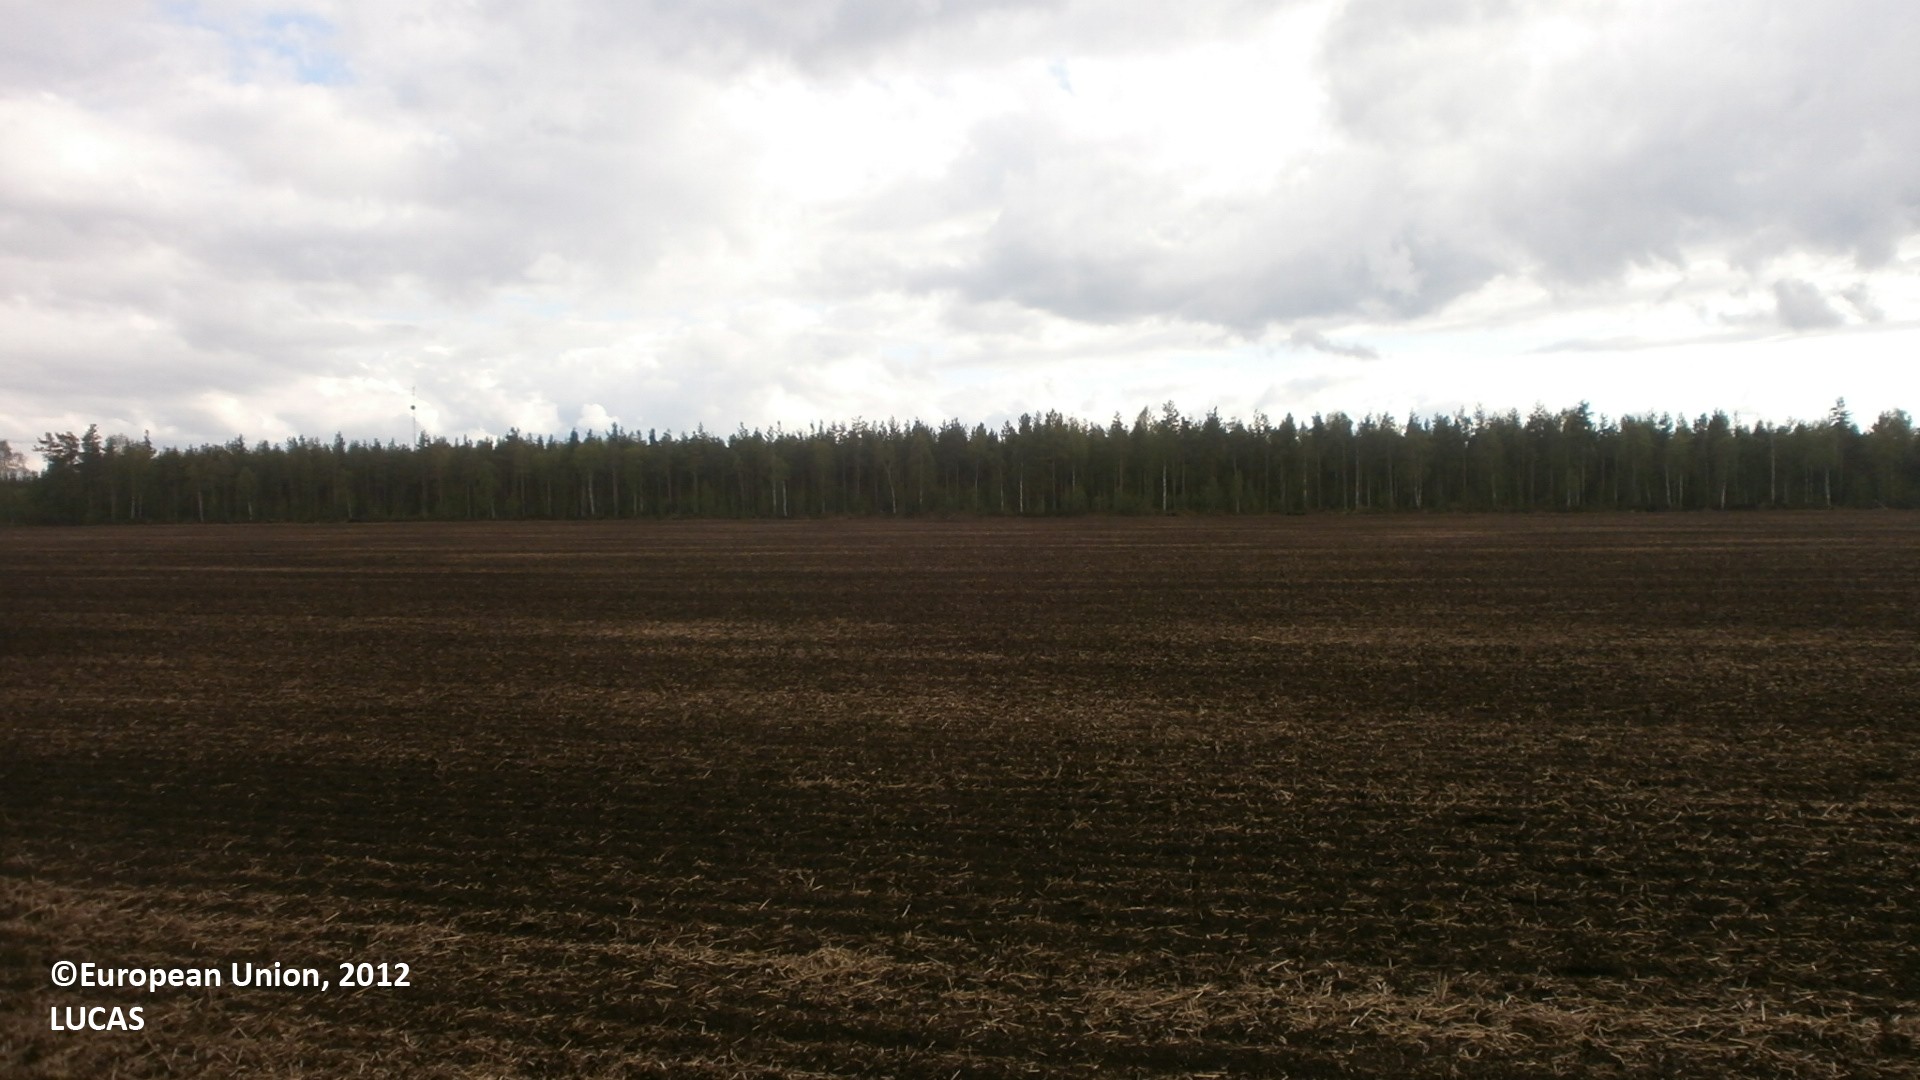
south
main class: Cropland
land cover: Barley
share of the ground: < 10 %
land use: Agriculture (excluding fallow land and kitchen gardens)
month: June
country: FI
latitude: 64.6808
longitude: 25.1481
